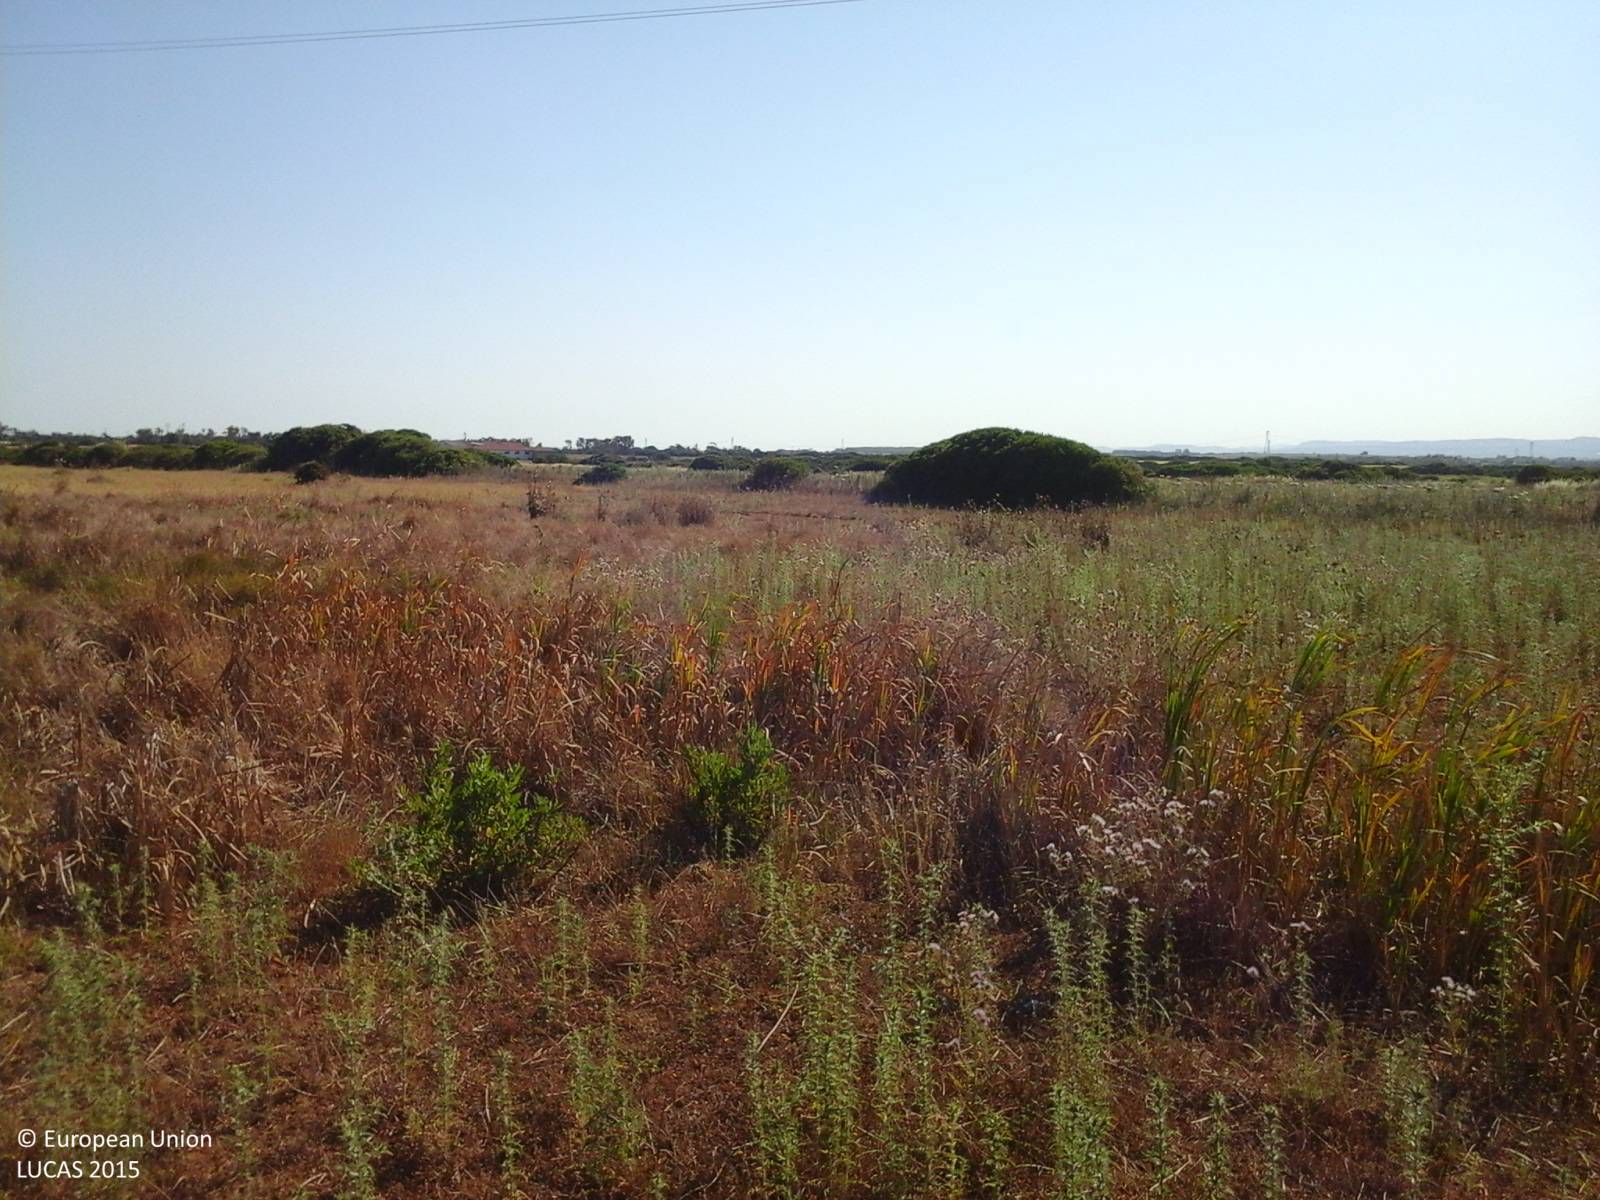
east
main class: Grassland
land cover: Spontaneously vegetated surfaces
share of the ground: > 75 %
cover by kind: herbaceous plants 95 %, shrubs 5 %
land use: Agriculture (excluding fallow land and kitchen gardens)
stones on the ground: < 10 %
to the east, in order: Spontaneously vegetated surfaces; Fences; Grassland without tree/shrub cover; Electric lines; Grassland without tree/shrub cover; Fences; Tracks; Abandoned hedges; Fences; Grassland without tree/shrub cover
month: June
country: IT
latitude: 40.7243
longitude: 8.3622
